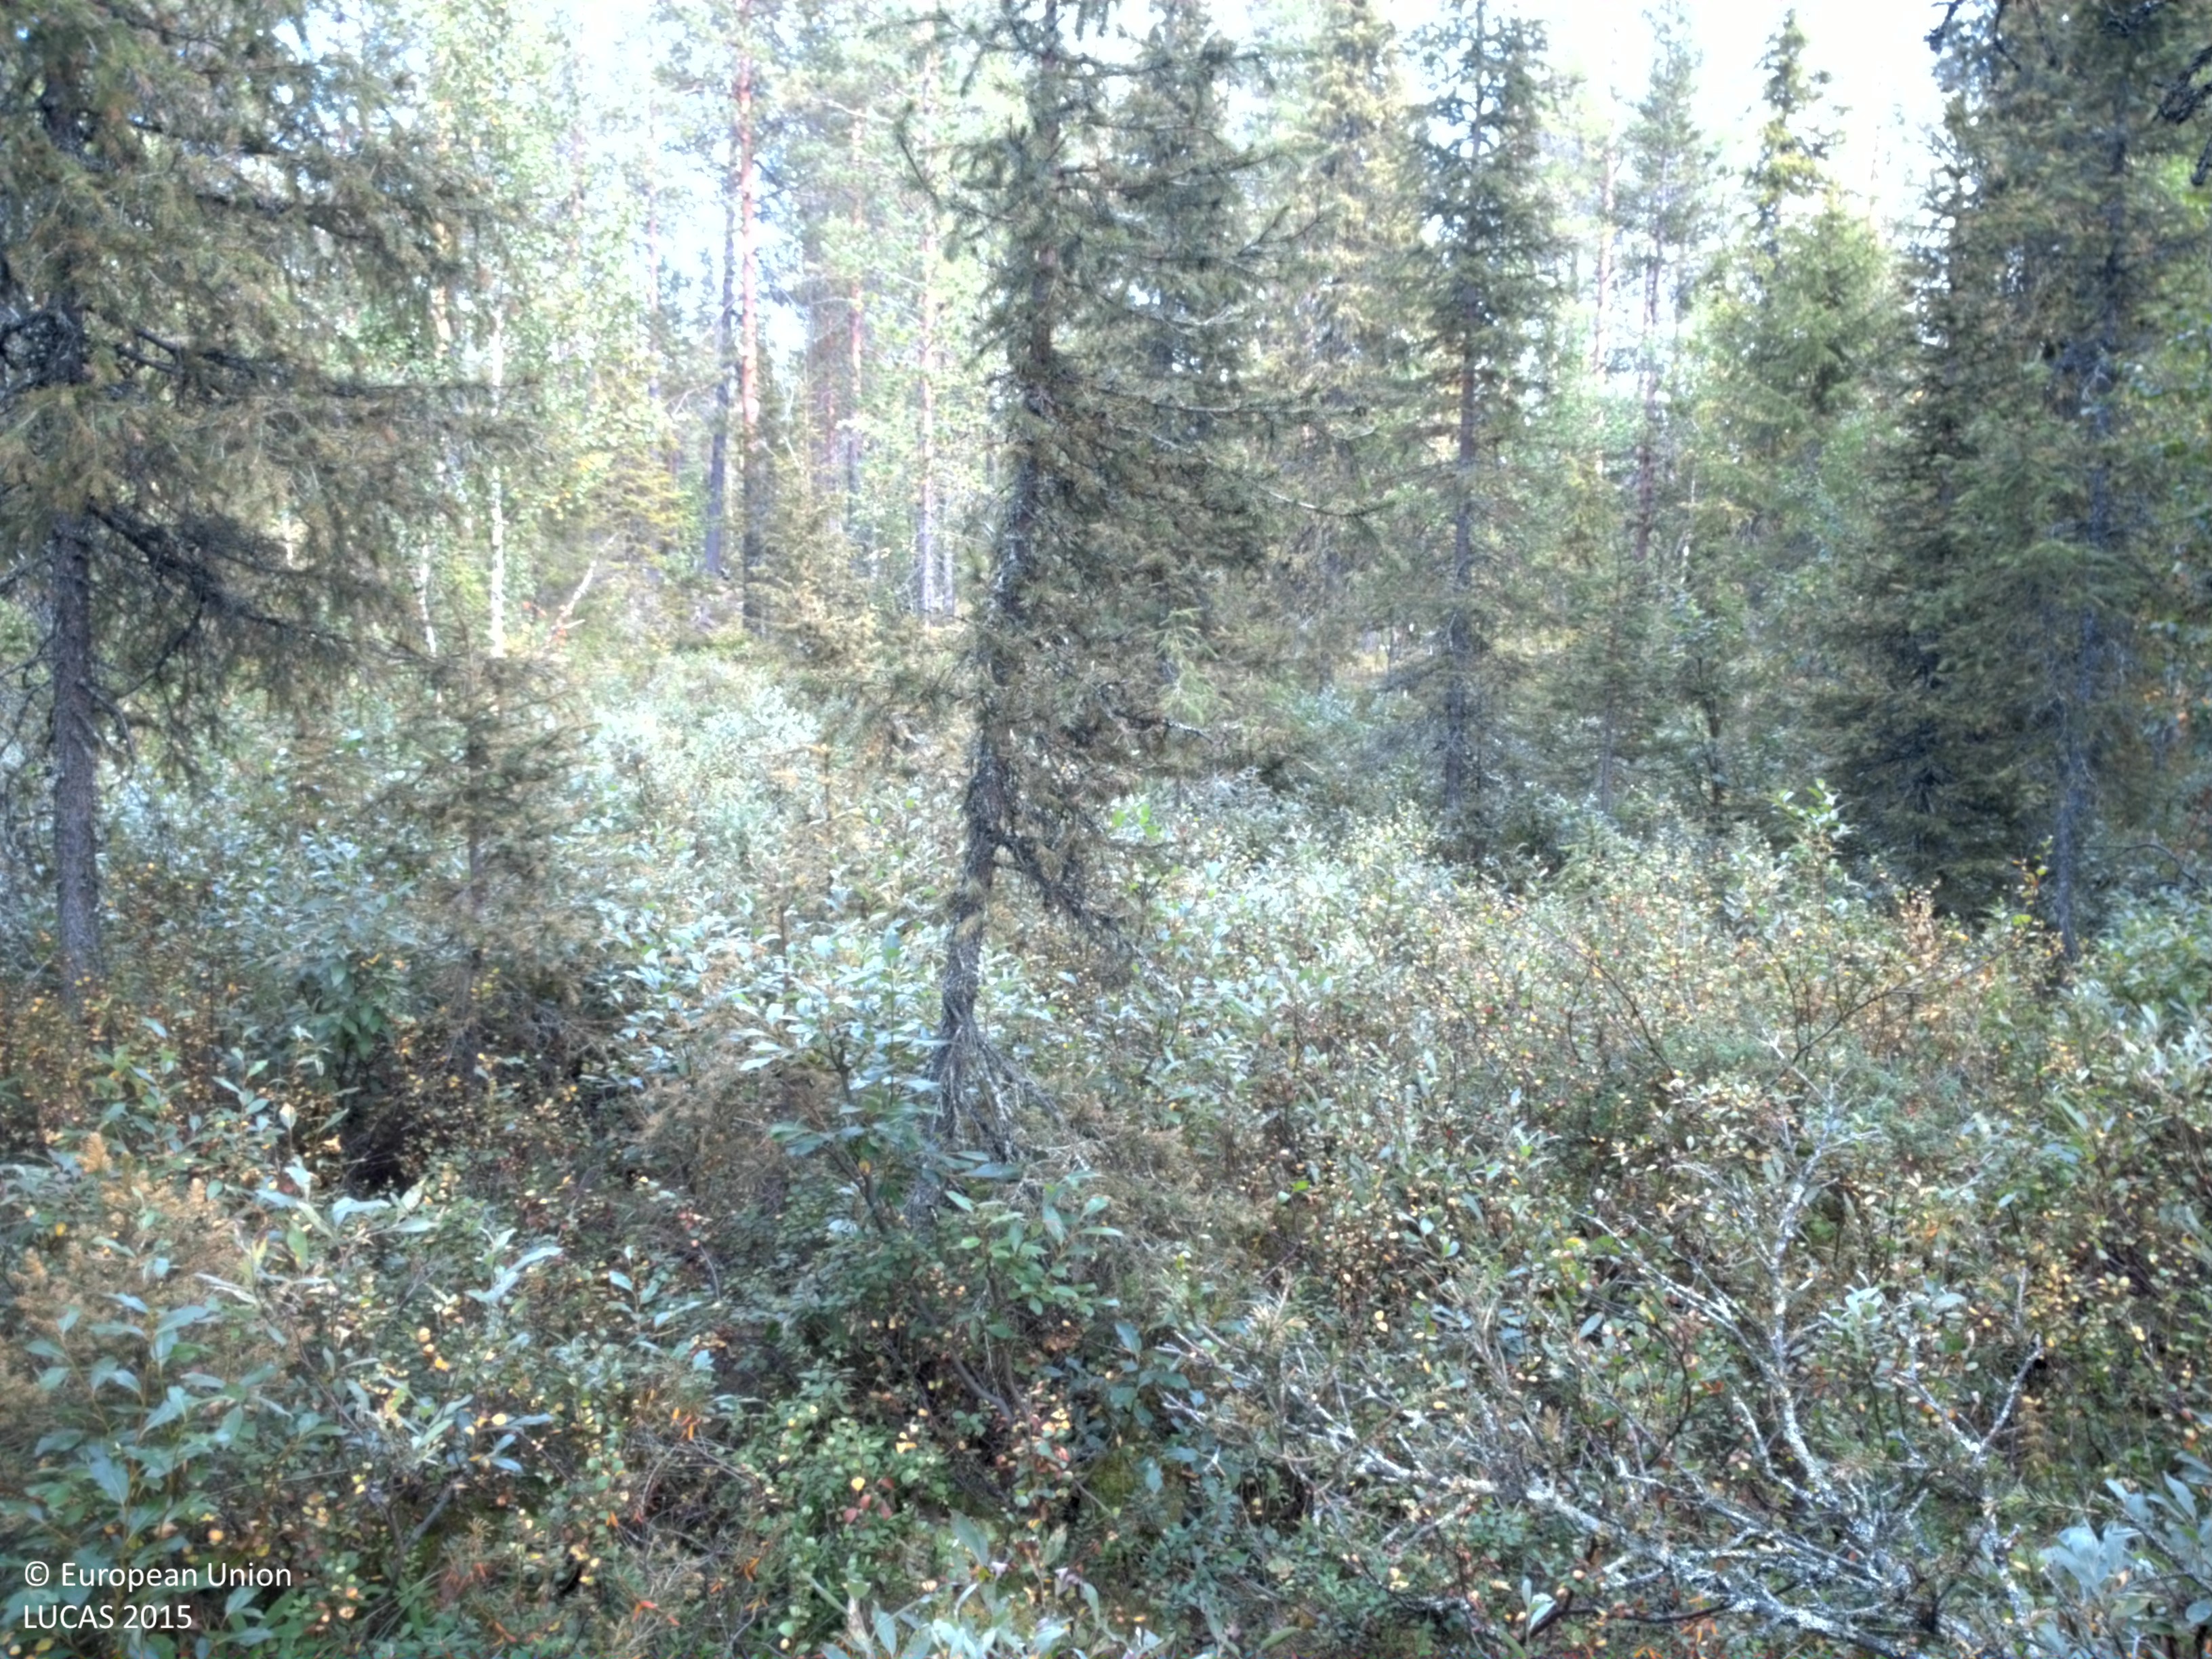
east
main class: Woodland
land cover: Pine dominated mixed woodland
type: boreal forest
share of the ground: 25 - 50 %
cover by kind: shrubs 60 %, coniferous forest trees 25 %, broadleaved forest trees 10 %, lichens and mosses 5 %
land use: Forestry
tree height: > 5 m
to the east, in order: Pine dominated mixed woodland; Pine dominated coniferous woodland; Spruce dominated mixed woodland; Pine dominated coniferous woodland; Spruce dominated mixed woodland; Pine dominated coniferous woodland; Spruce dominated mixed woodland; Spruce dominated coniferous woodland
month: August
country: SE
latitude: 66.9124
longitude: 19.6608
